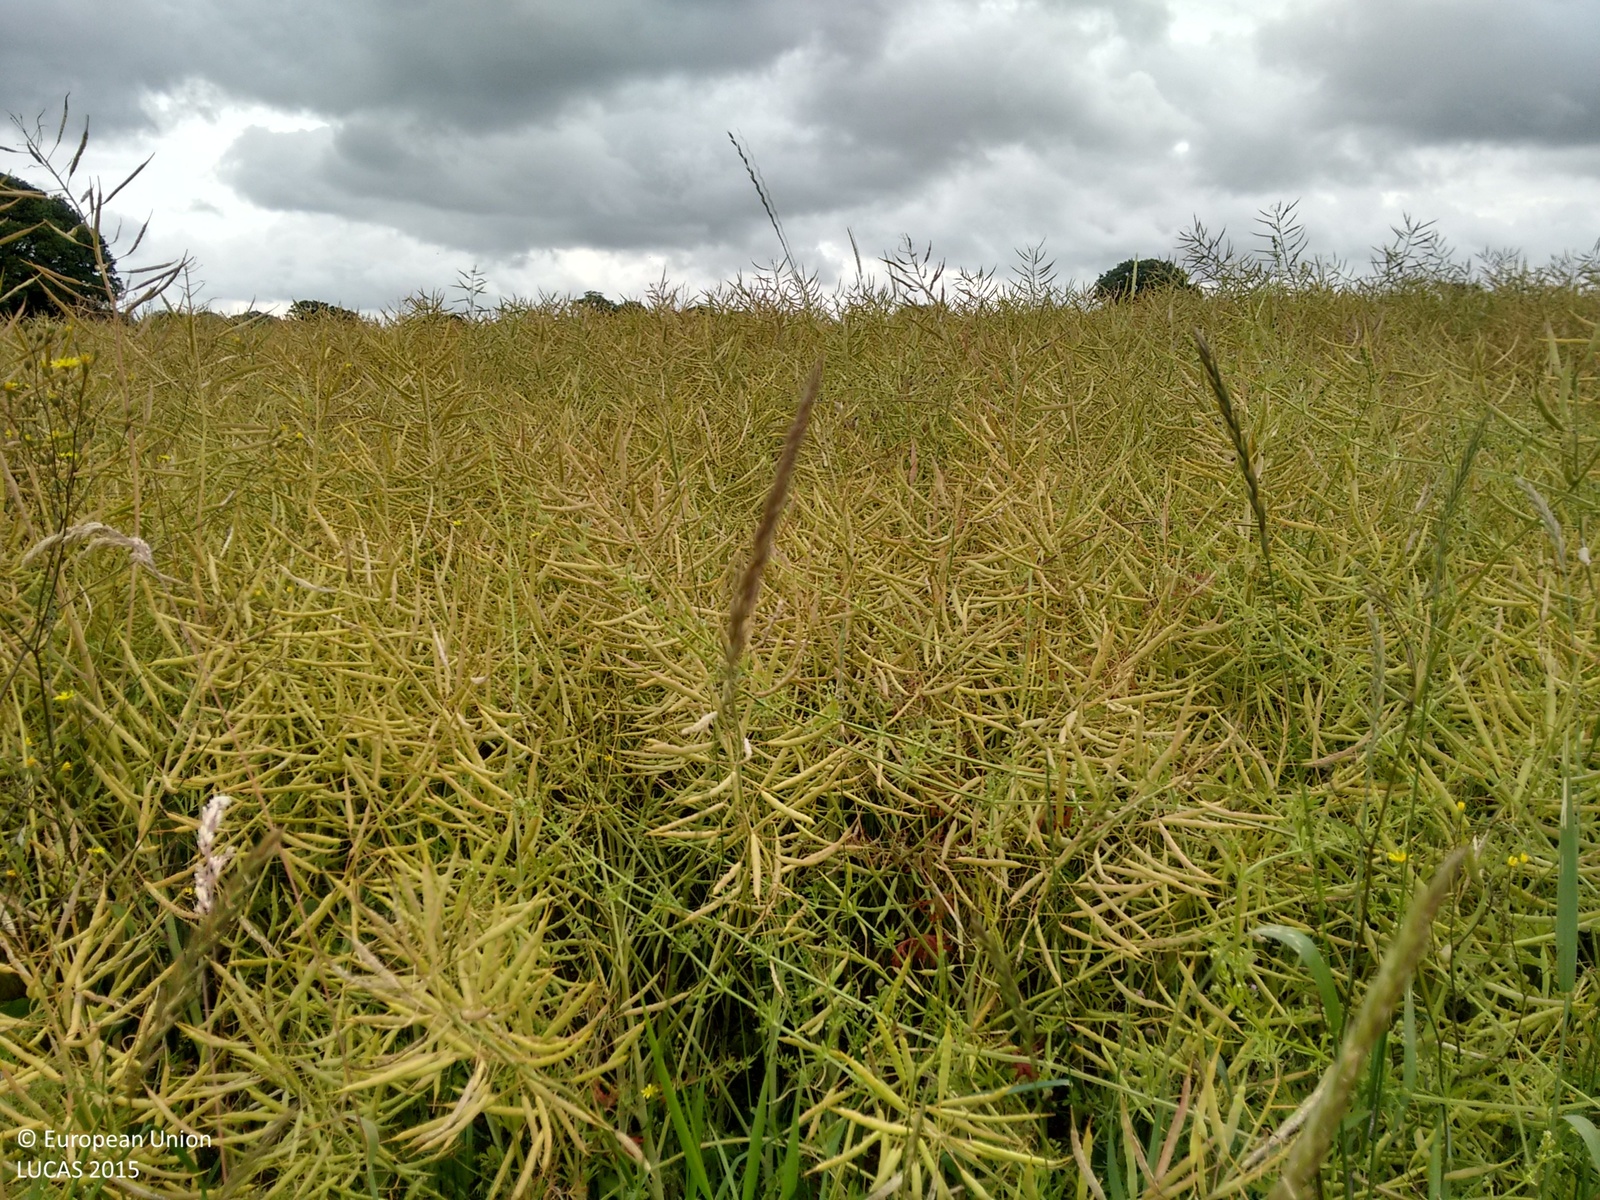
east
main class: Cropland
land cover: Rape and turnip rape
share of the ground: > 75 %
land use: Agriculture (excluding fallow land and kitchen gardens)
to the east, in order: Rape and turnip rape; Grass margins; Ditches and canals; Managed hedges; Electric lines; Fences; Grass margins; Paved roads, cycling and walking lanes; Grass margins; Managed hedges; Apple fruit
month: July
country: GB
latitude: 52.0555
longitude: -2.5363
